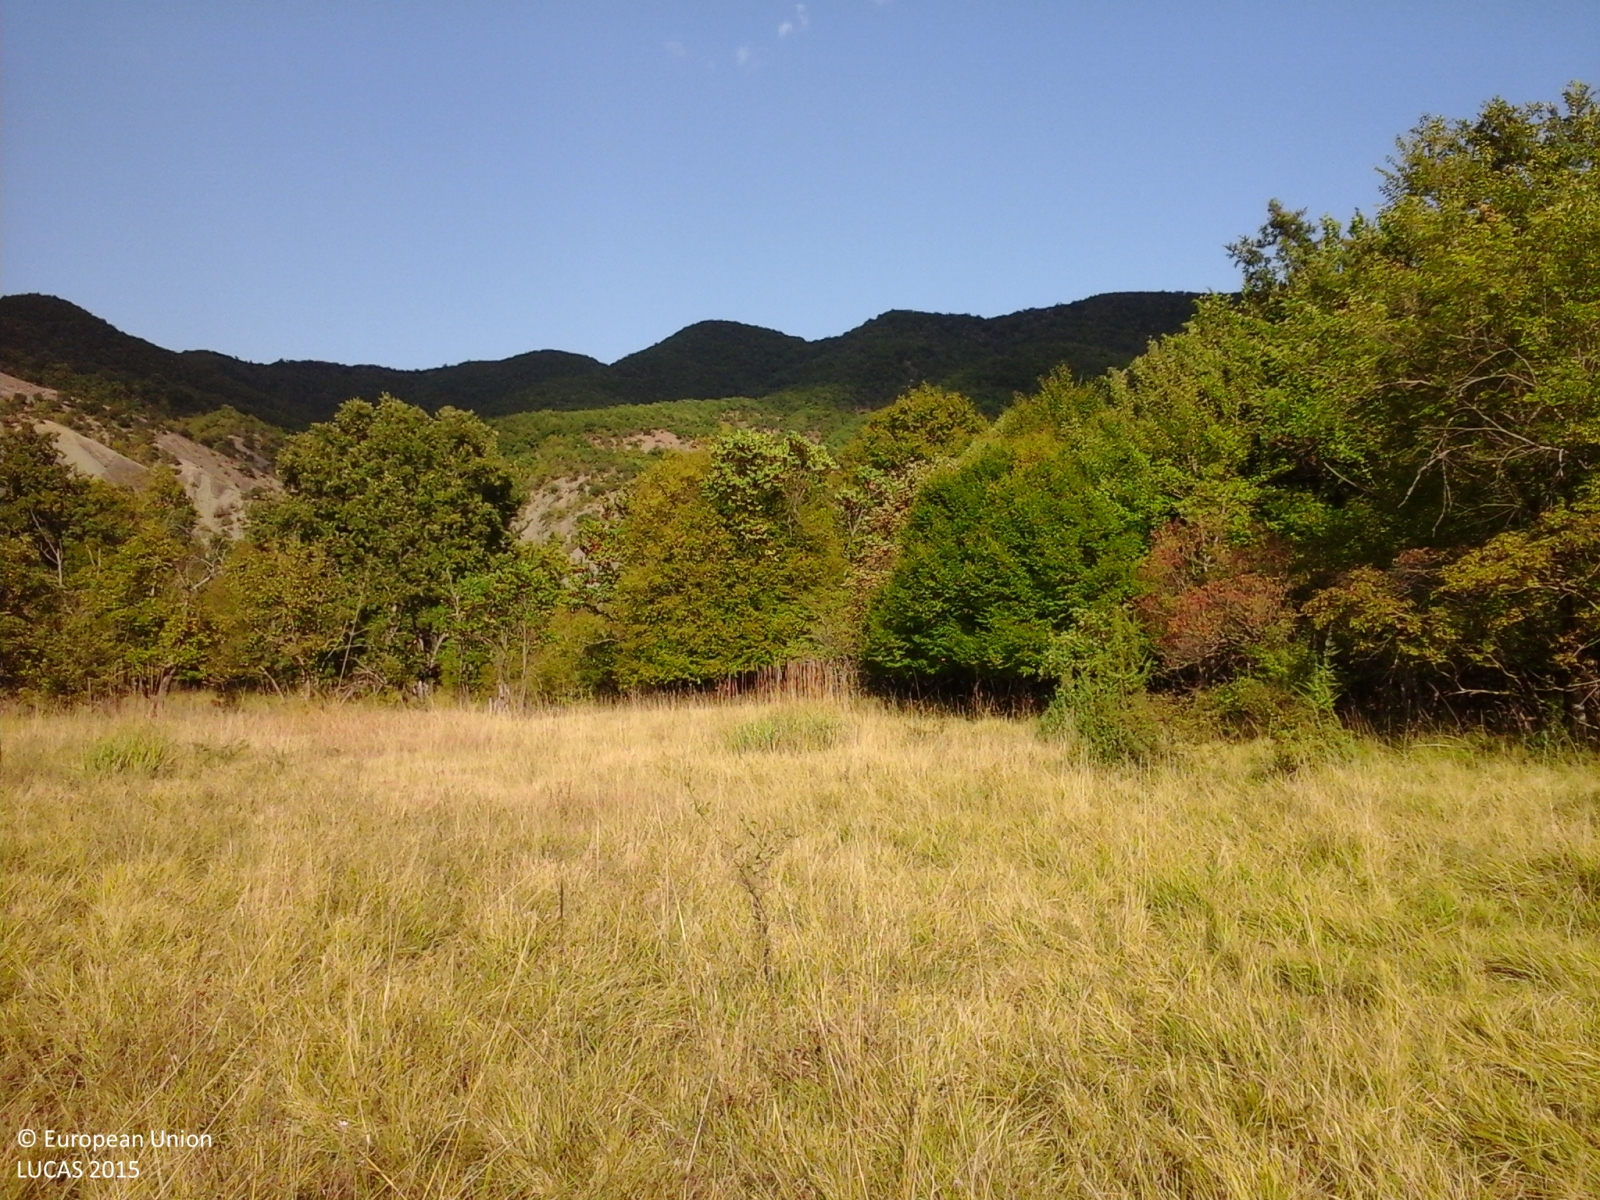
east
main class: Grassland
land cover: Grassland without tree/shrub cover
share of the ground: > 75 %
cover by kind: herbaceous plants 100 %
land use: Agriculture (excluding fallow land and kitchen gardens)
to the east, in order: Grassland without tree/shrub cover; Broadleaved woodland; Inland fresh running water; Broadleaved woodland; Tracks; Grassland without tree/shrub cover; Broadleaved woodland; Grassland without tree/shrub cover; Broadleaved woodland; Rocks and stones
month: September
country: GR
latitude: 39.7451
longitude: 20.9380
